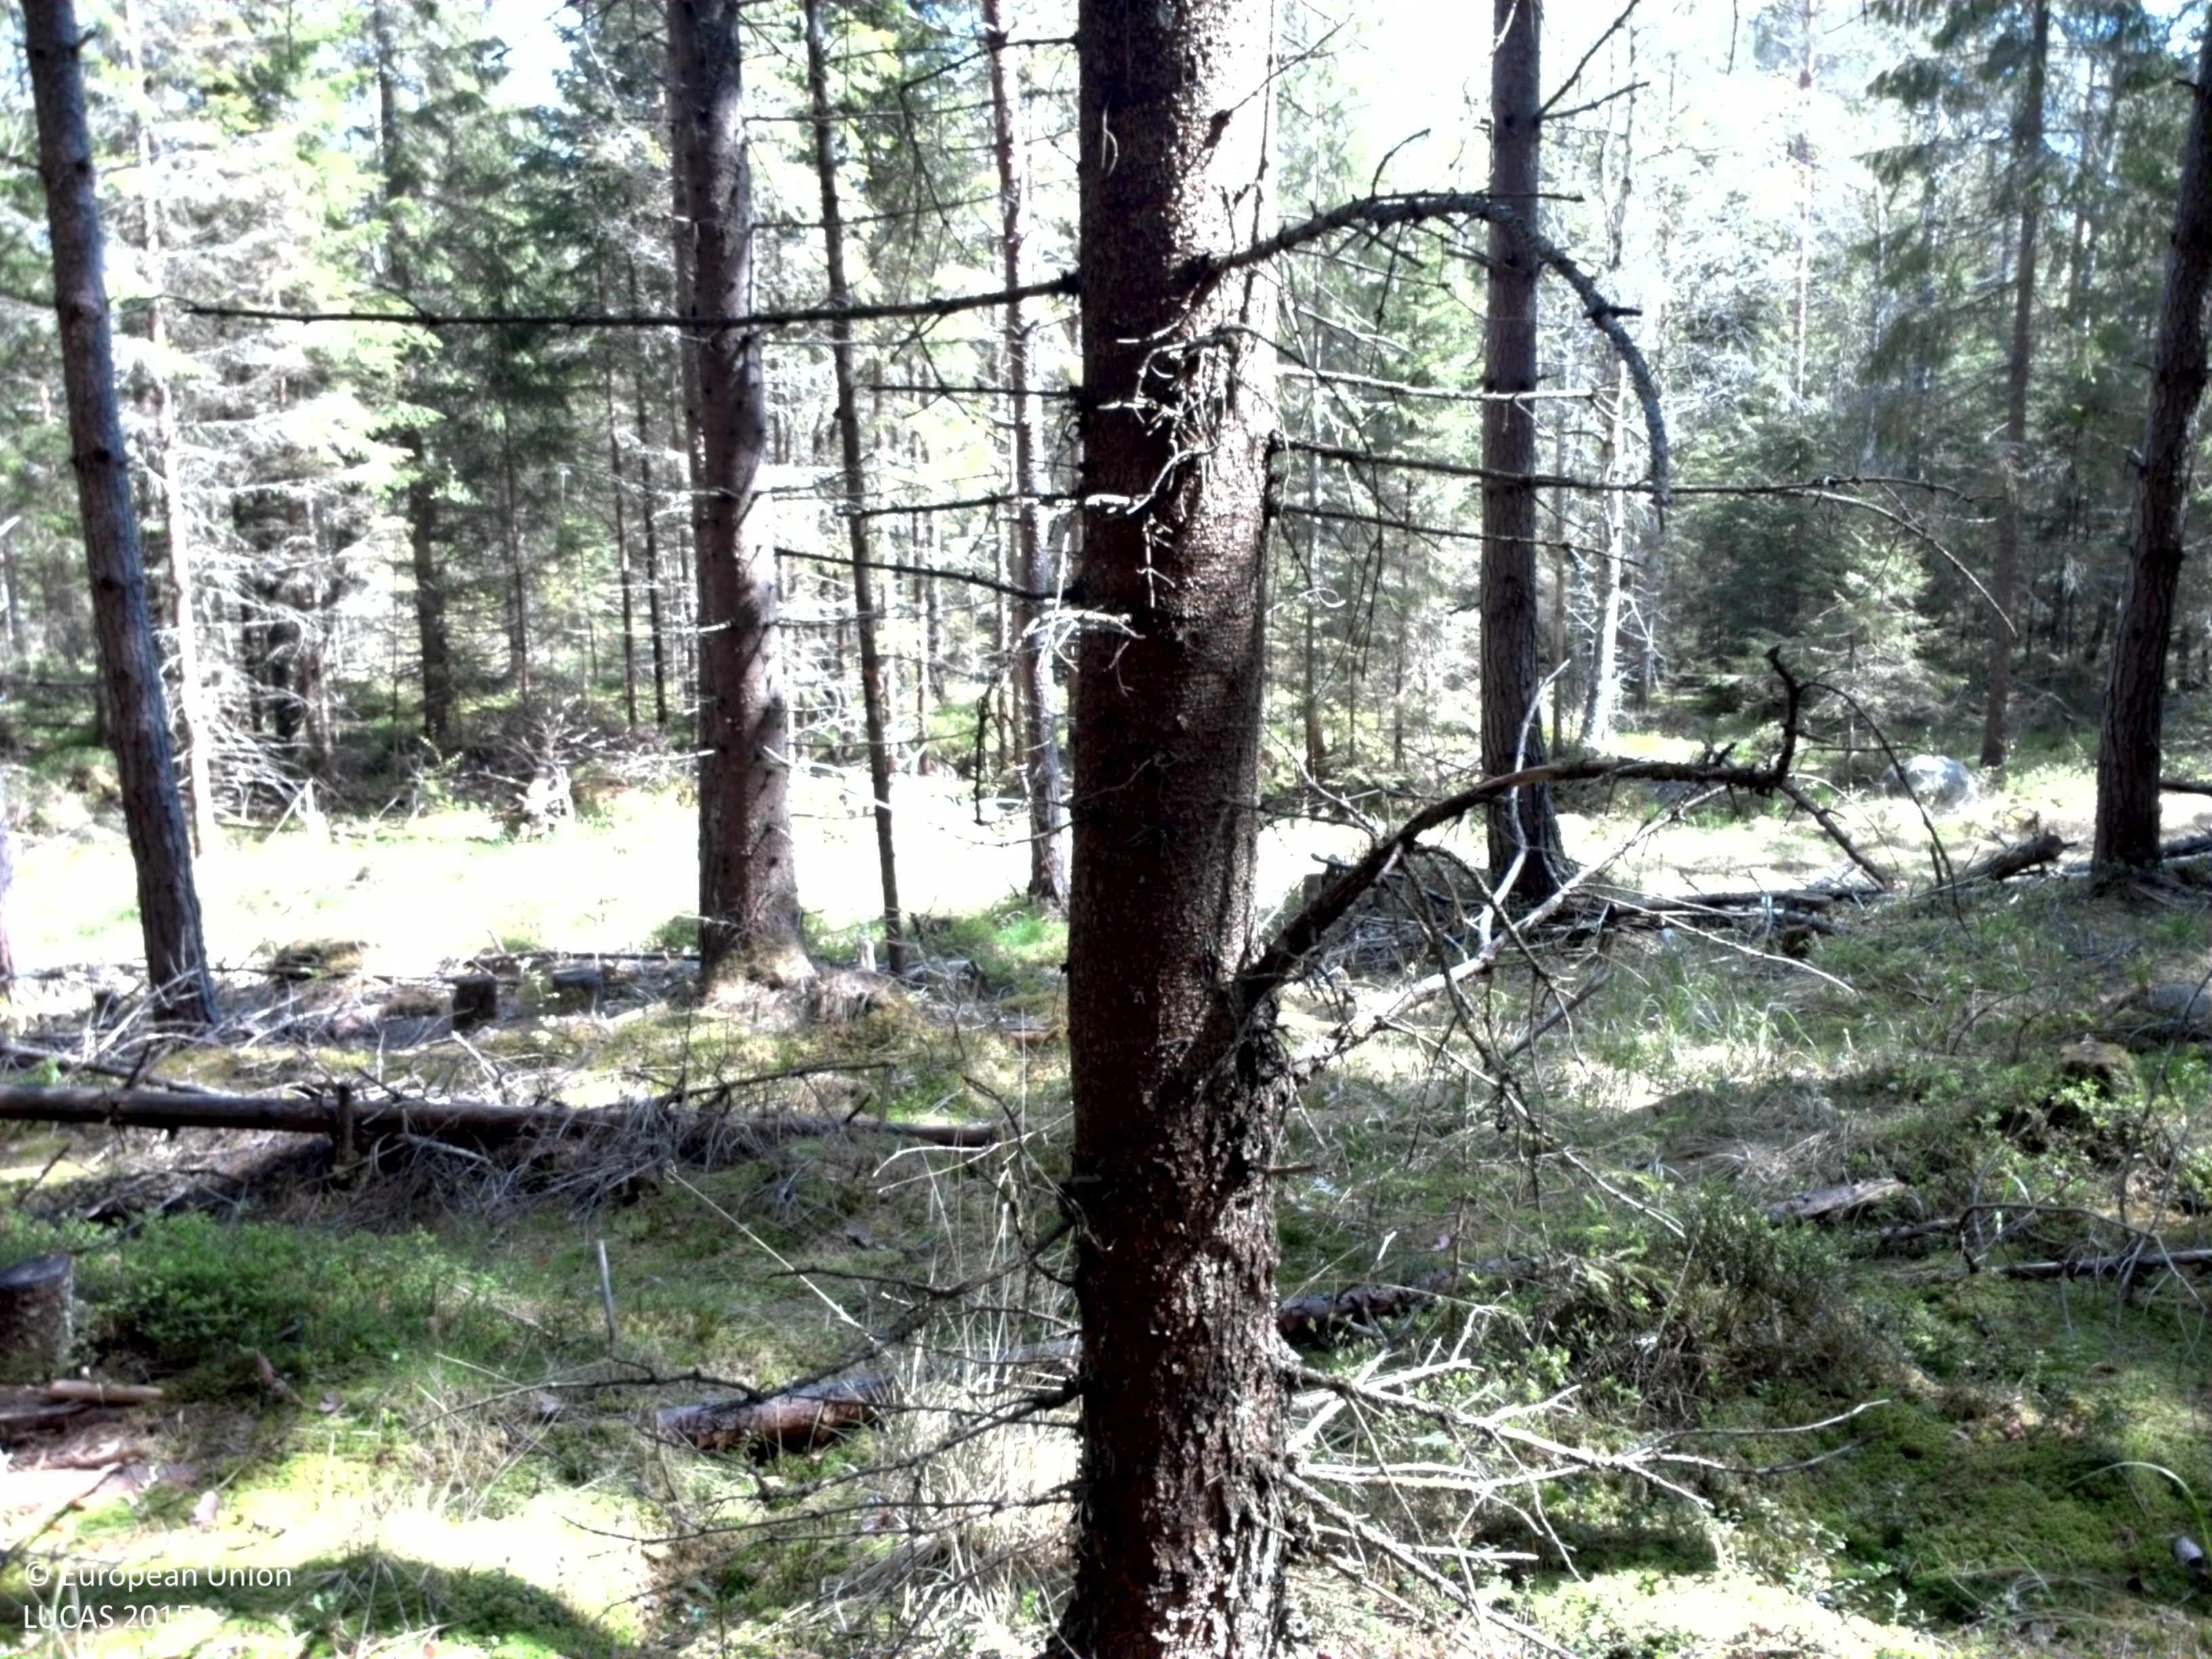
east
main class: Woodland
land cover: Spruce dominated coniferous woodland
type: boreal forest
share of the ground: > 75 %
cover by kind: coniferous forest trees 70 %, herbaceous plants 15 %, lichens and mosses 10 %, broadleaved forest trees 5 %
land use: Forestry
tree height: > 5 m
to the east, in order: Spruce dominated coniferous woodland; Rivers and streams; Pine dominated coniferous woodland; Broadleaved woodland; Electric lines; Grassland without tree/shrub cover; Broadleaved woodland; Grass margins; Paved roads, cycling and walking lanes; Grassland without tree/shrub cover; Spruce dominated coniferous woodland; Ditches and canals; Spruce dominated coniferous woodland
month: May
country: SE
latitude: 59.5135
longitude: 12.3090
